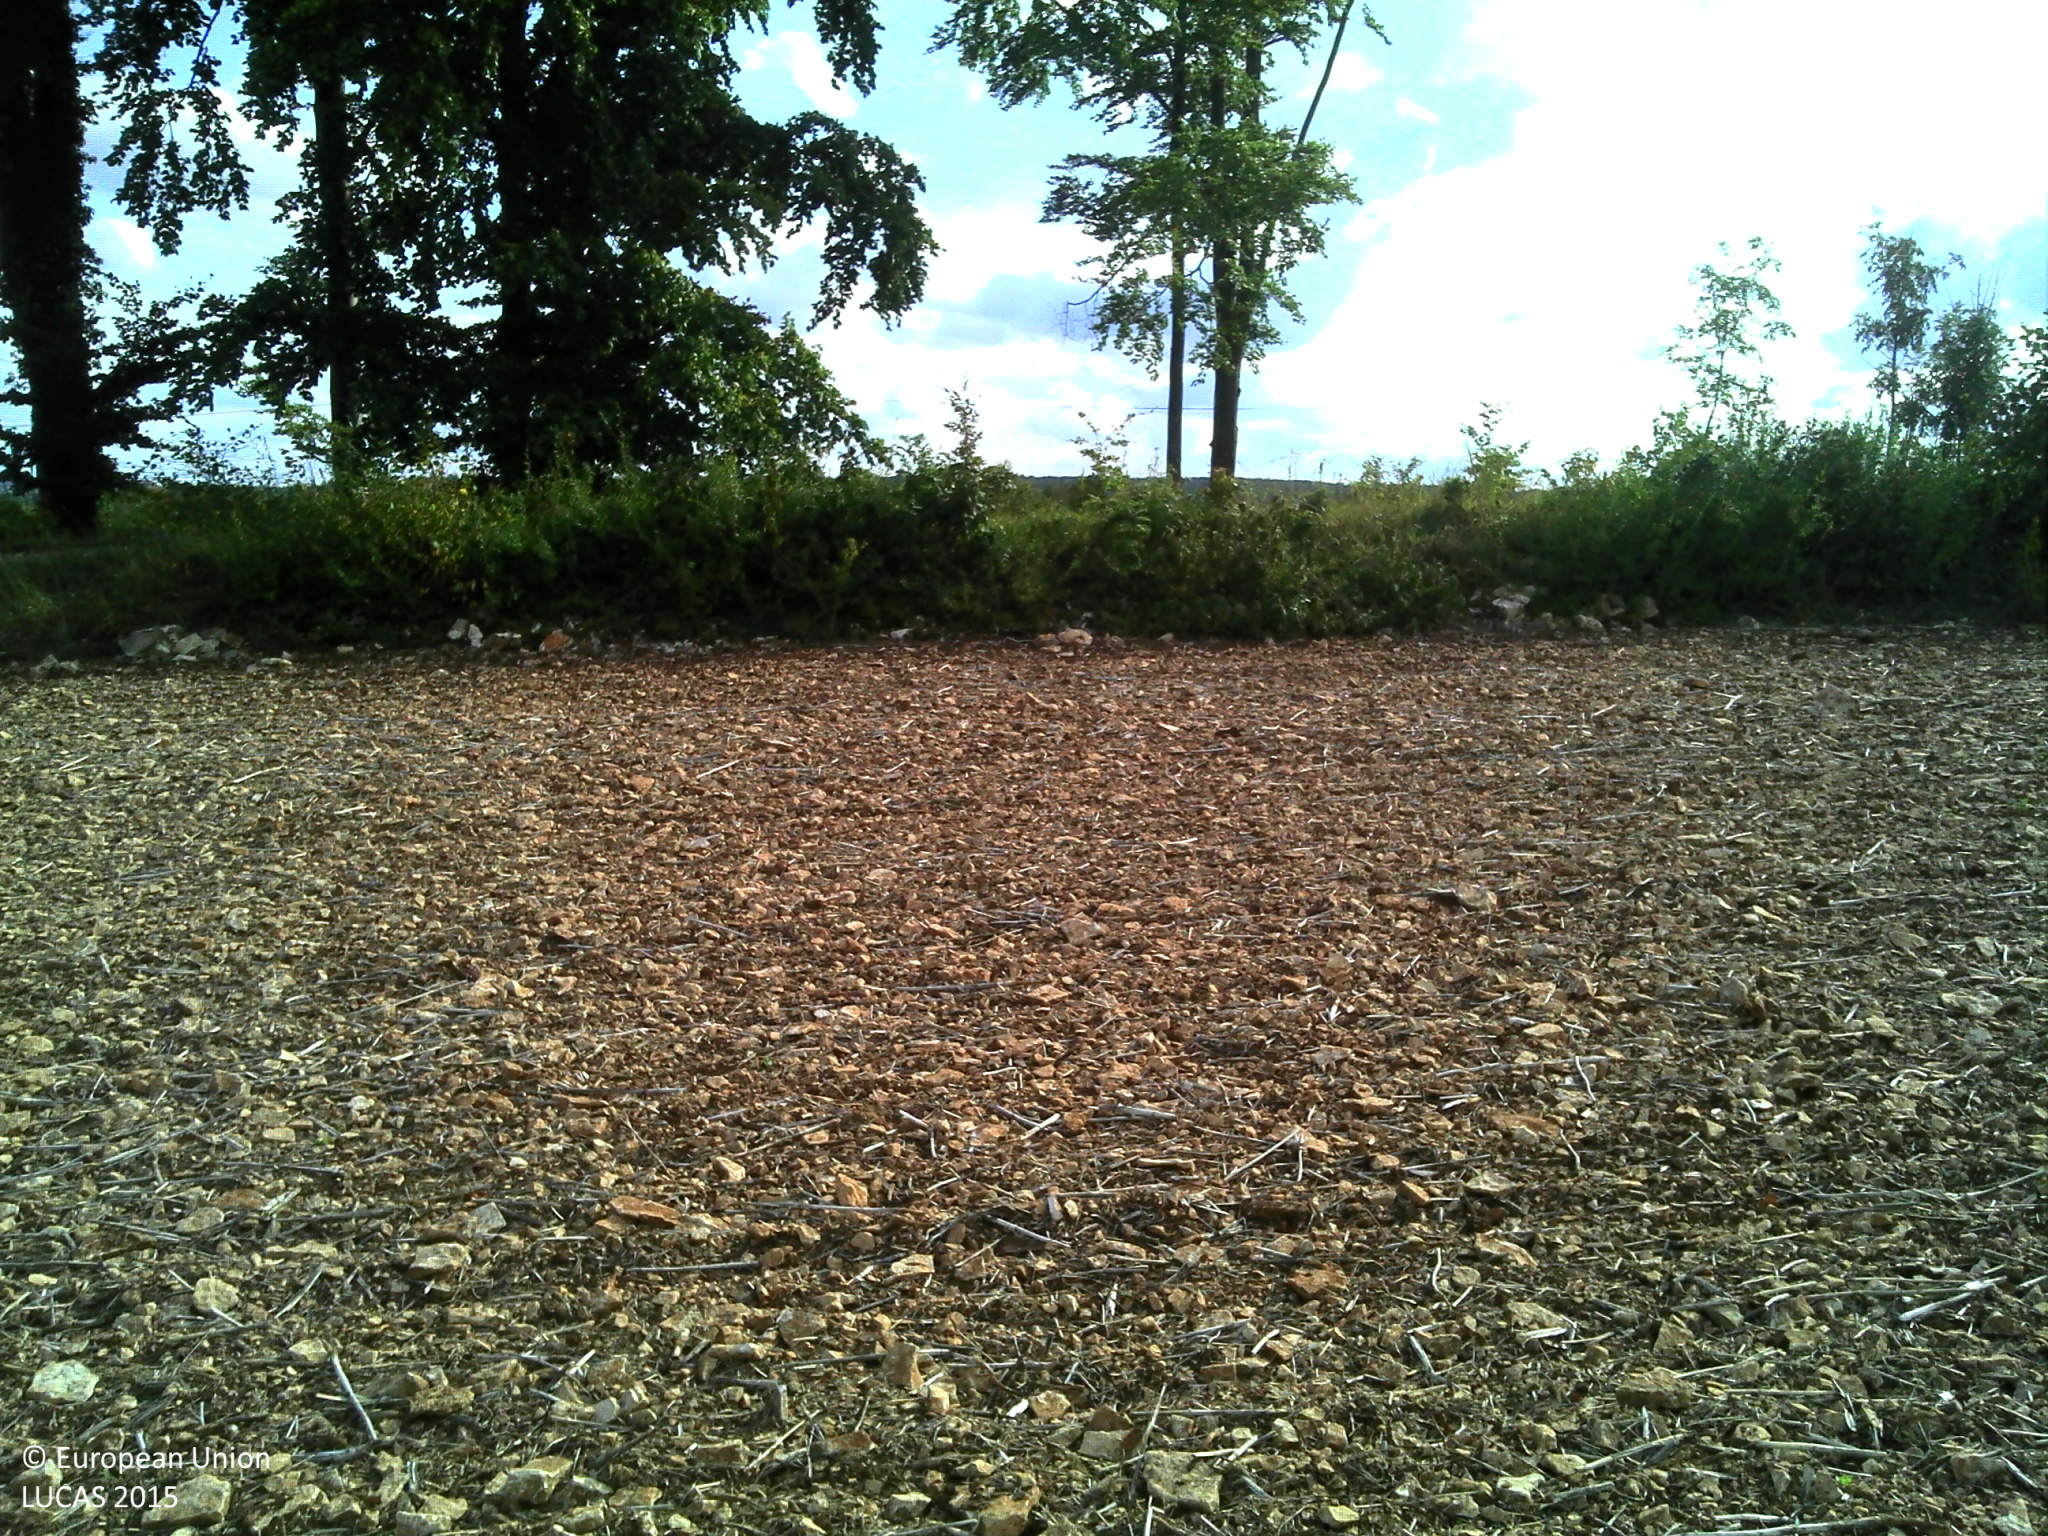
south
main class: Cropland
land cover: Rape and turnip rape
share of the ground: 25 - 50 %
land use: Agriculture (excluding fallow land and kitchen gardens)
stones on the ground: 25 - 50 %
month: September
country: FR
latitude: 47.5600
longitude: 4.8031
